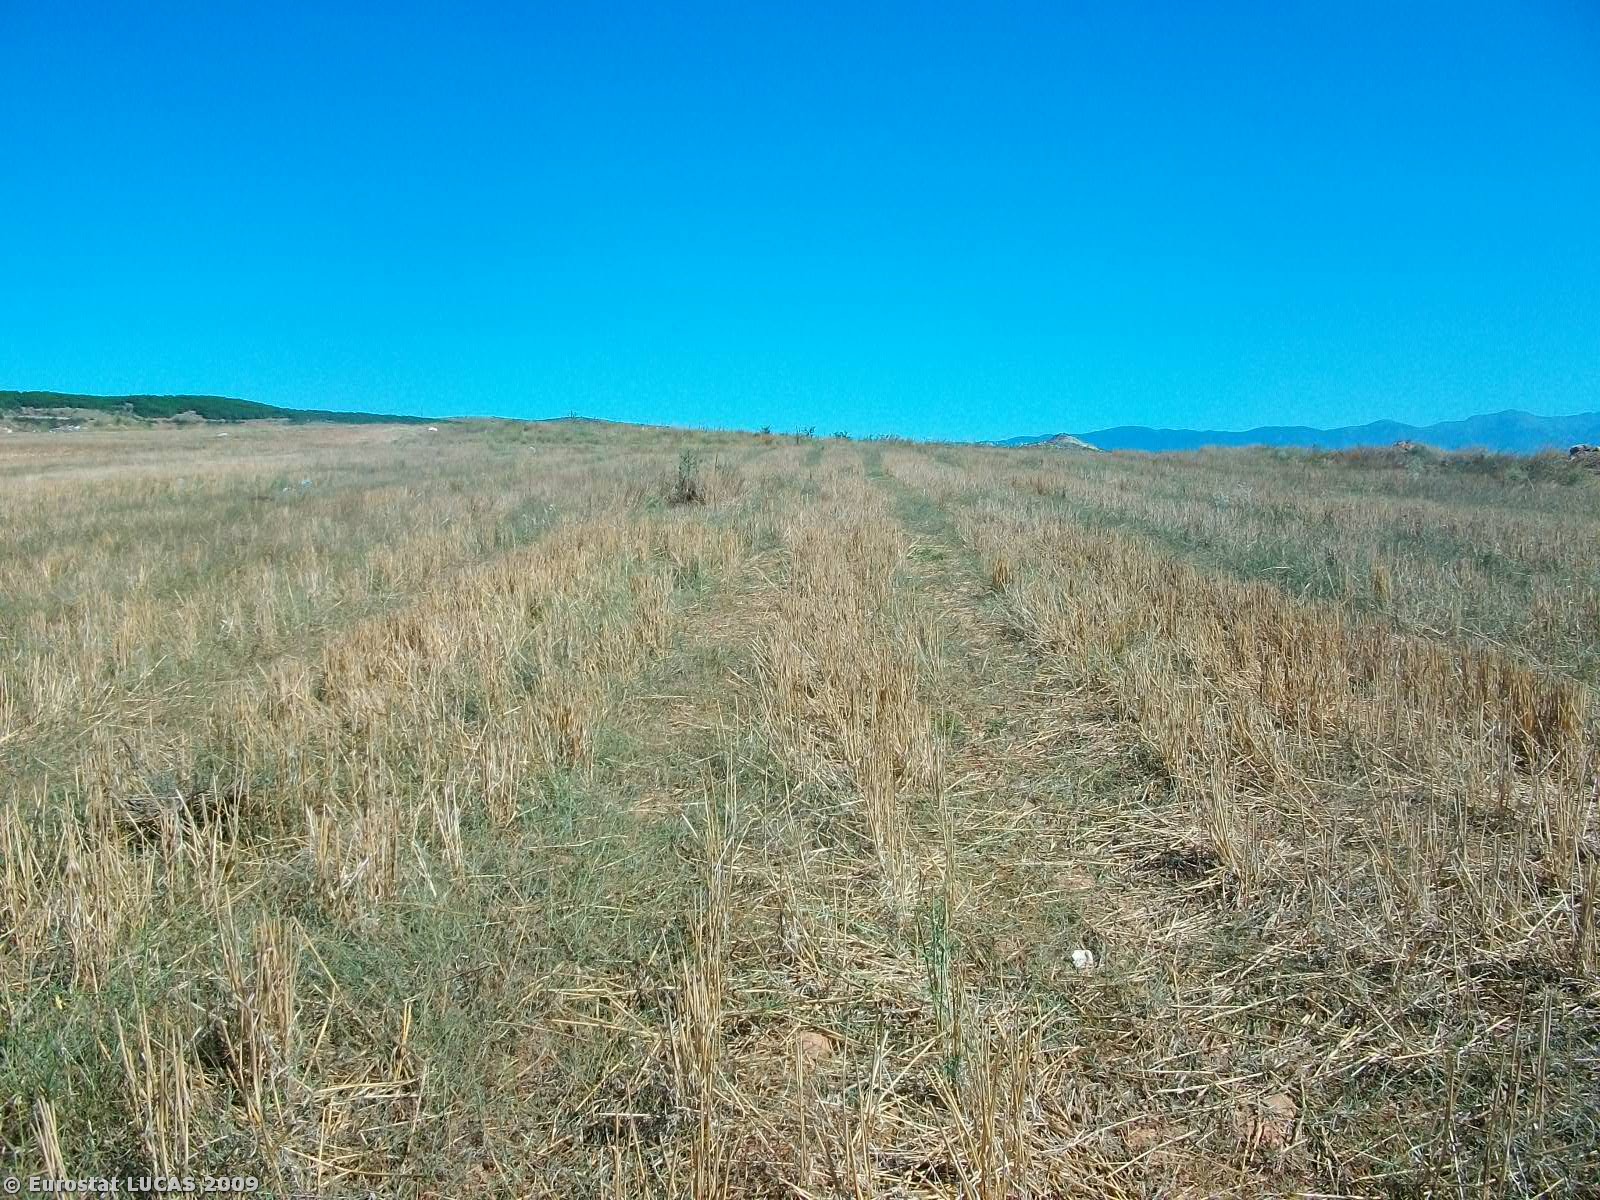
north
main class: Cropland
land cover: Barley
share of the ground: < 10 %
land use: Agriculture (excluding fallow land and kitchen gardens)
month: July
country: GR
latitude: 41.0942
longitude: 22.7610
